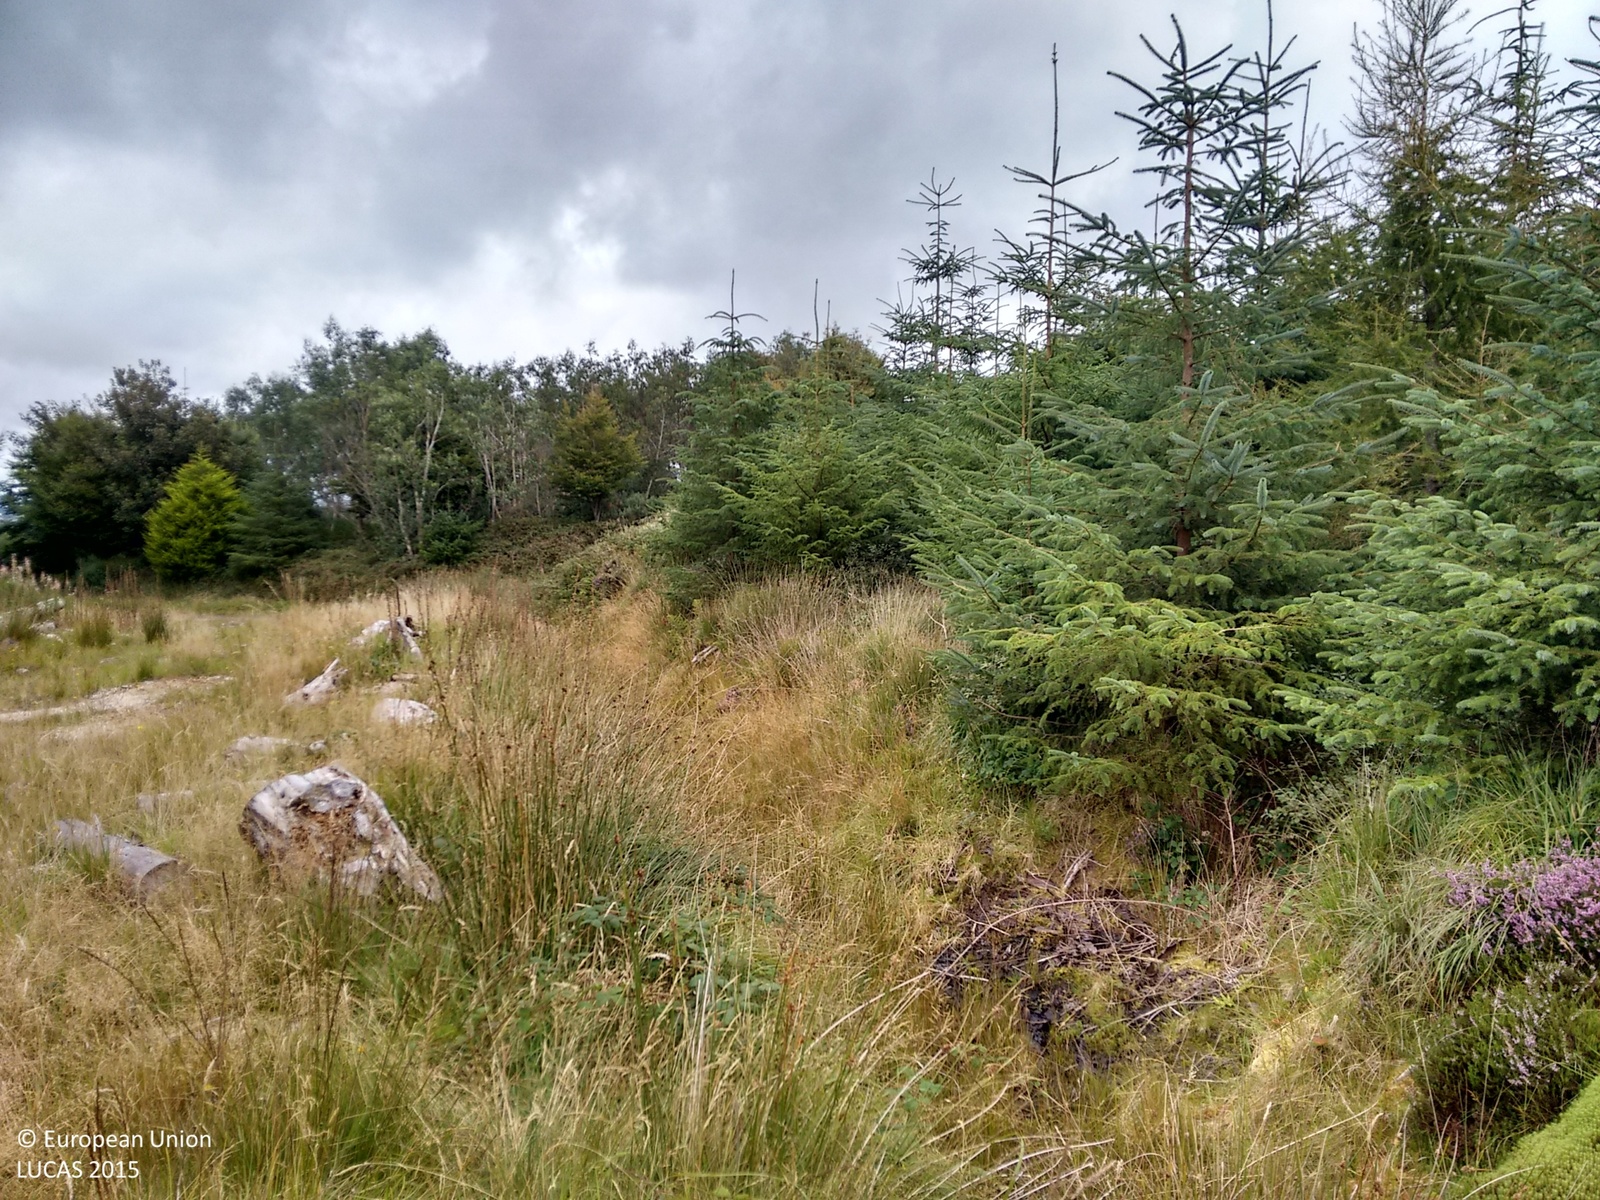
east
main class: Woodland
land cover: Spruce dominated coniferous woodland
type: exotic forest
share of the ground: > 75 %
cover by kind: coniferous forest trees 95 %, herbaceous plants 5 %
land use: Forestry
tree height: > 5 m
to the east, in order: Spruce dominated coniferous woodland; Shrubland without tree cover; Ditches and canals; Grass margins; Tracks; Grass margins; Ditches and canals; Broadleaved woodland; Spontaneously vegetated surfaces; Ditches and canals; Spontaneously vegetated surfaces; Ditches and canals; Spontaneously vegetated surfaces; Ditches and canals; Spruce dominated coniferous woodland; Spontaneously vegetated surfaces; Spruce dominated coniferous woodland; Spontaneously vegetated surfaces; Single bushes/trees; Spontaneously vegetated surfaces; Ditches and canals; Spontaneously vegetated surfaces
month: September
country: IE
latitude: 52.7993
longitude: -9.1286
